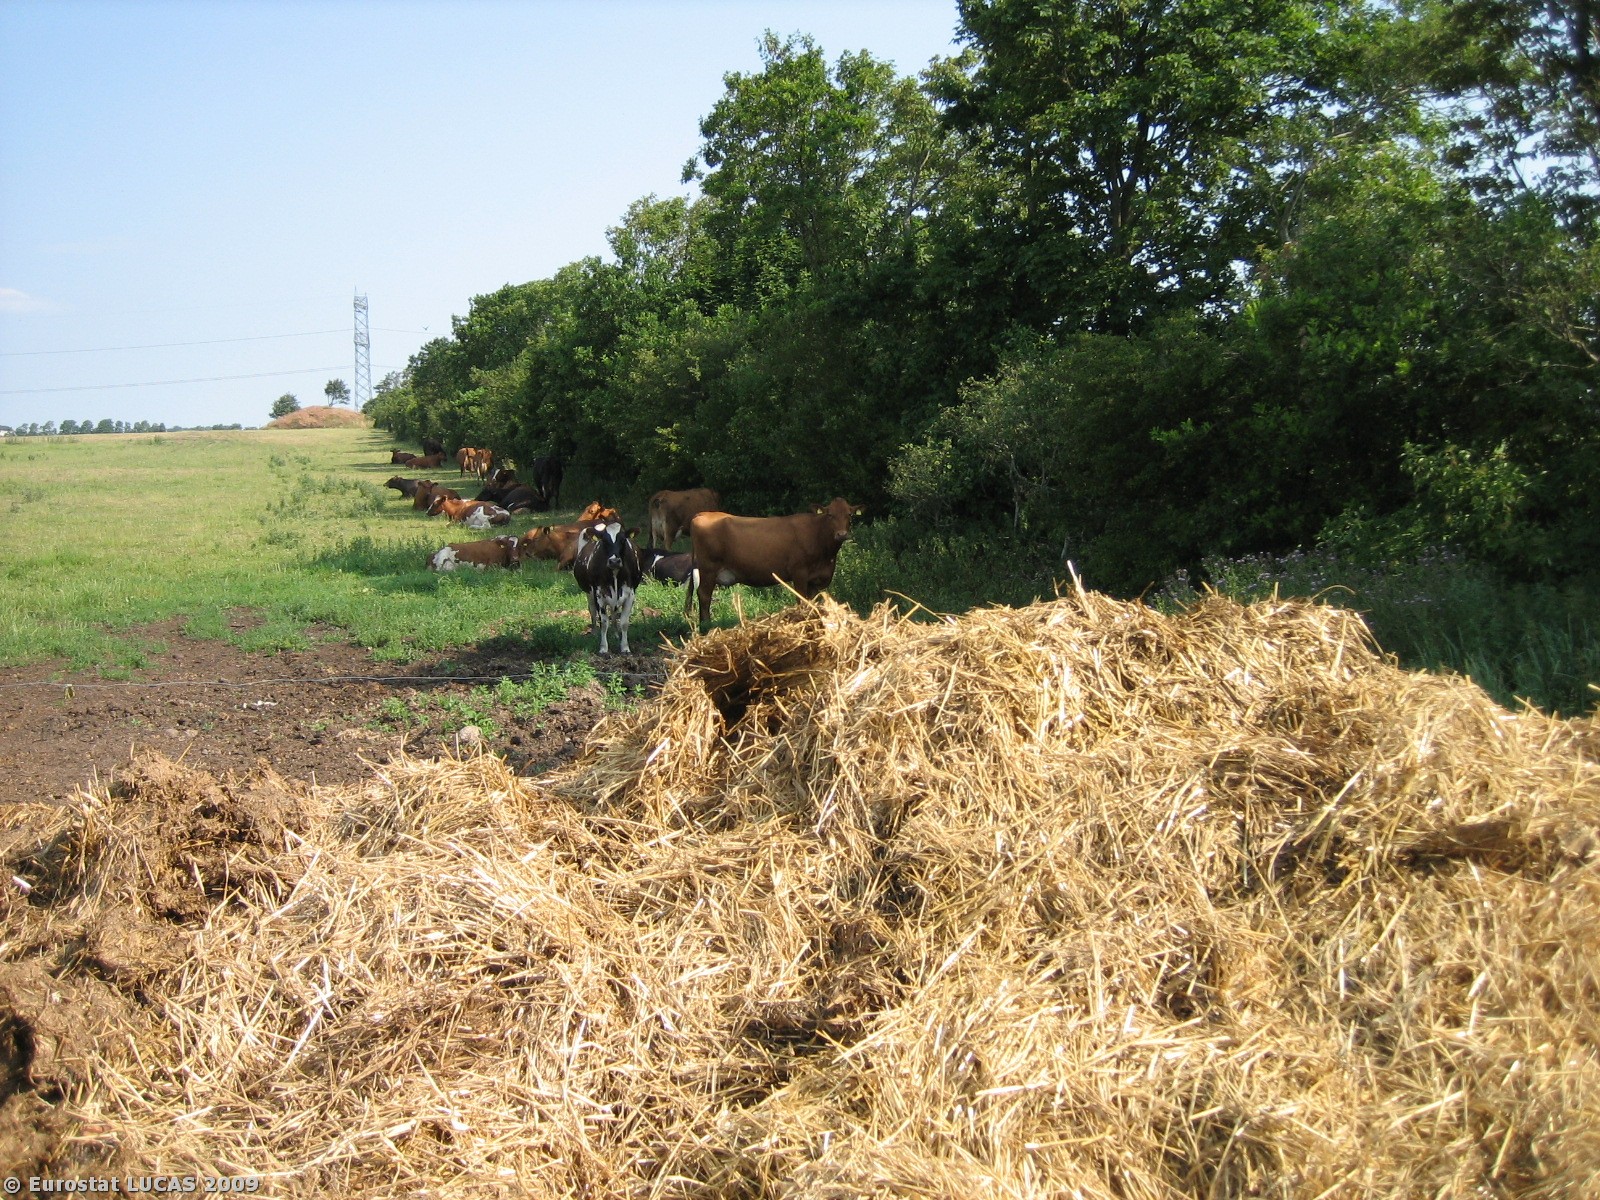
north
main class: Grassland
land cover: Grassland without tree/shrub cover
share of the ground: > 75 %
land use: Agriculture (excluding fallow land and kitchen gardens)
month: July
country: DK
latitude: 55.5187
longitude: 9.0031
